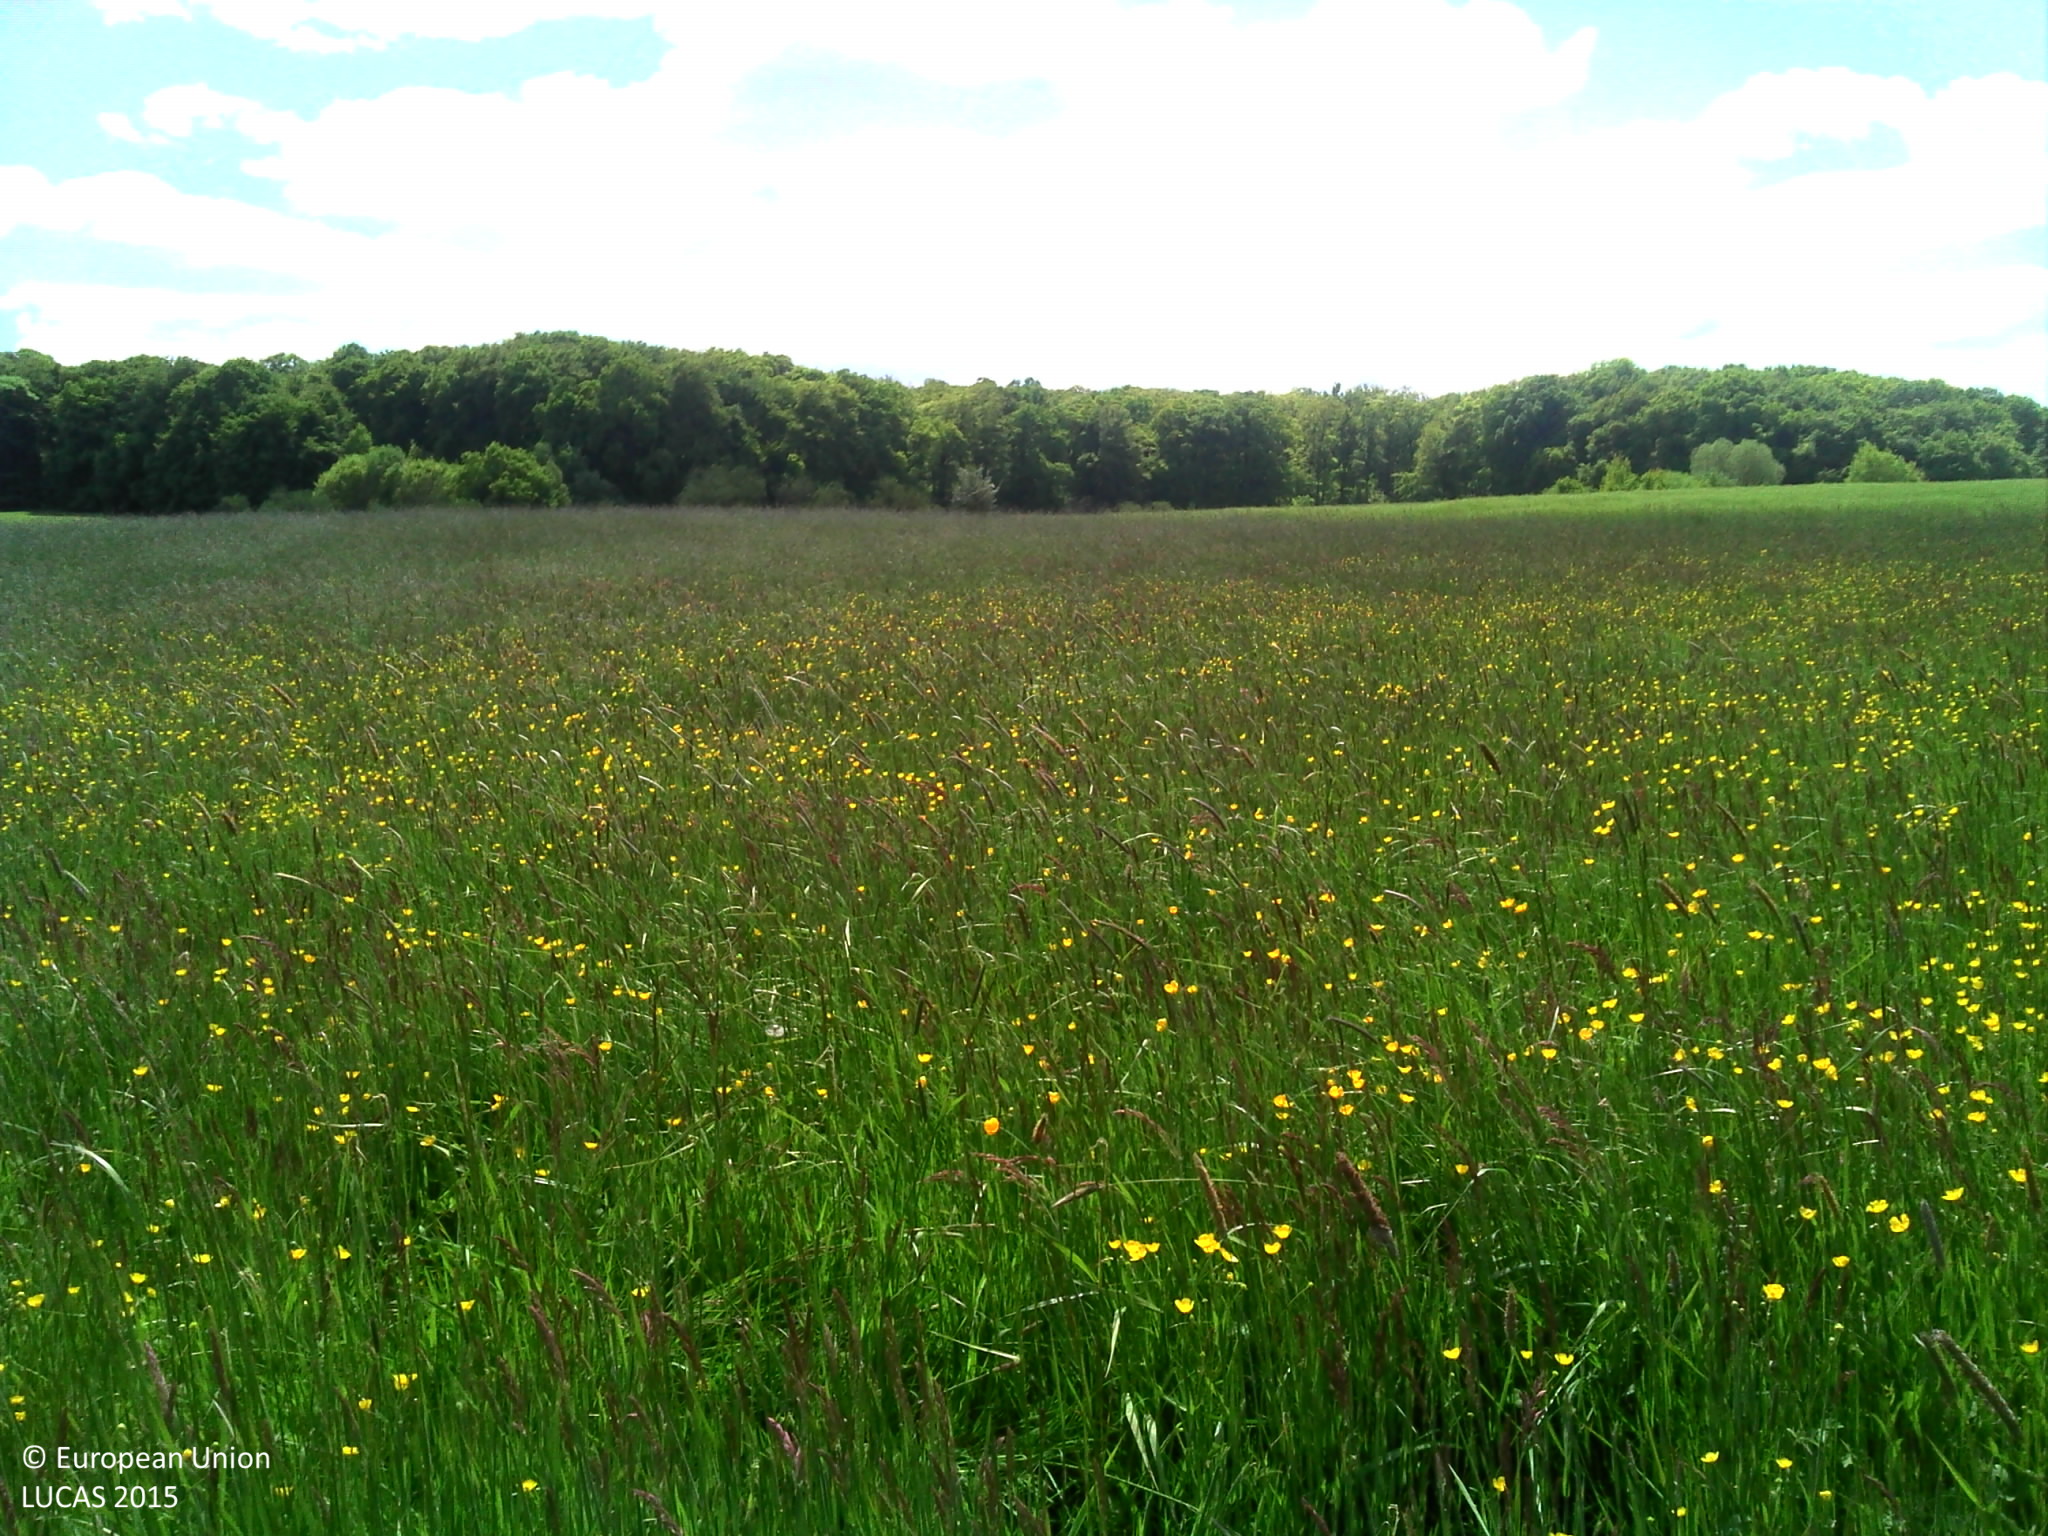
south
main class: Grassland
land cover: Grassland without tree/shrub cover
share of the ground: > 75 %
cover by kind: herbaceous plants 100 %
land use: Agriculture (excluding fallow land and kitchen gardens)
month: May
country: LU
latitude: 49.7101
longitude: 6.2969
